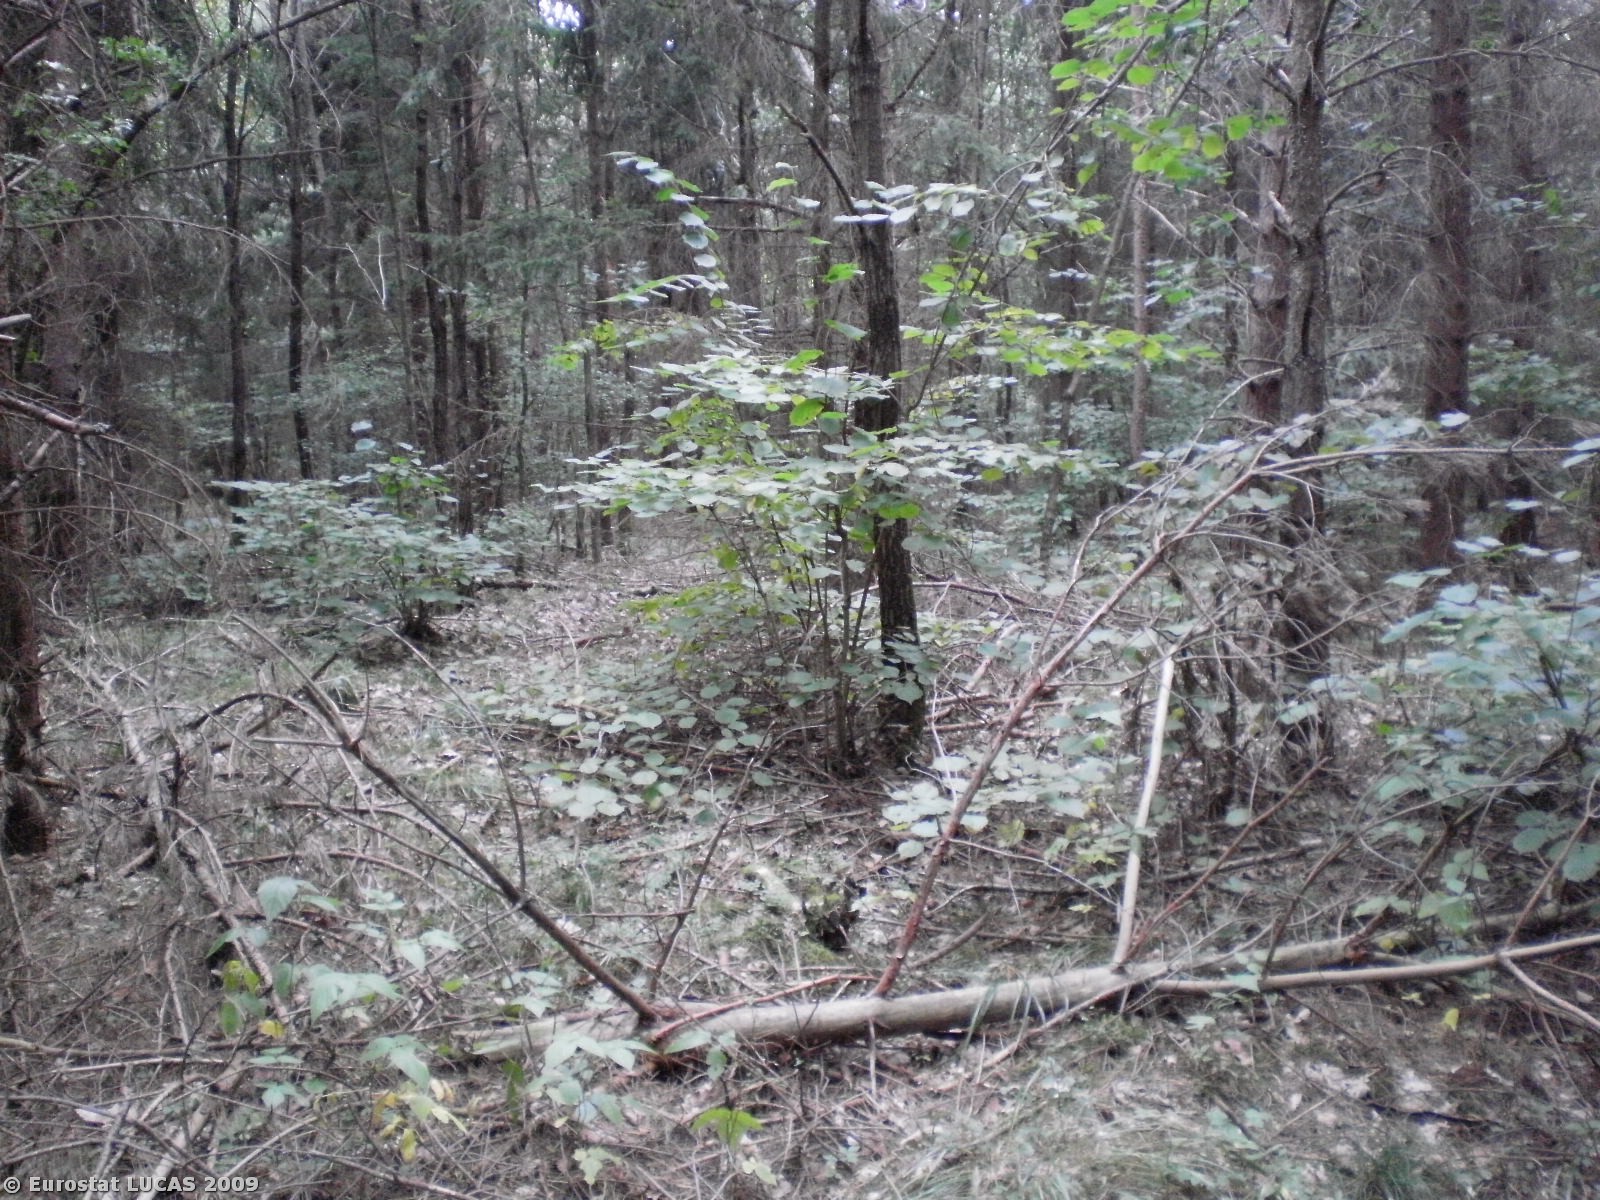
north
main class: Woodland
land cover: Coniferous woodland
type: hemiboreal forest and nemoral coniferous forest and mixed broadleaved-coniferous forest
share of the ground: > 75 %
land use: Forestry
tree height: > 5 m
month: September
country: PL
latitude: 53.7687
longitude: 21.4120
